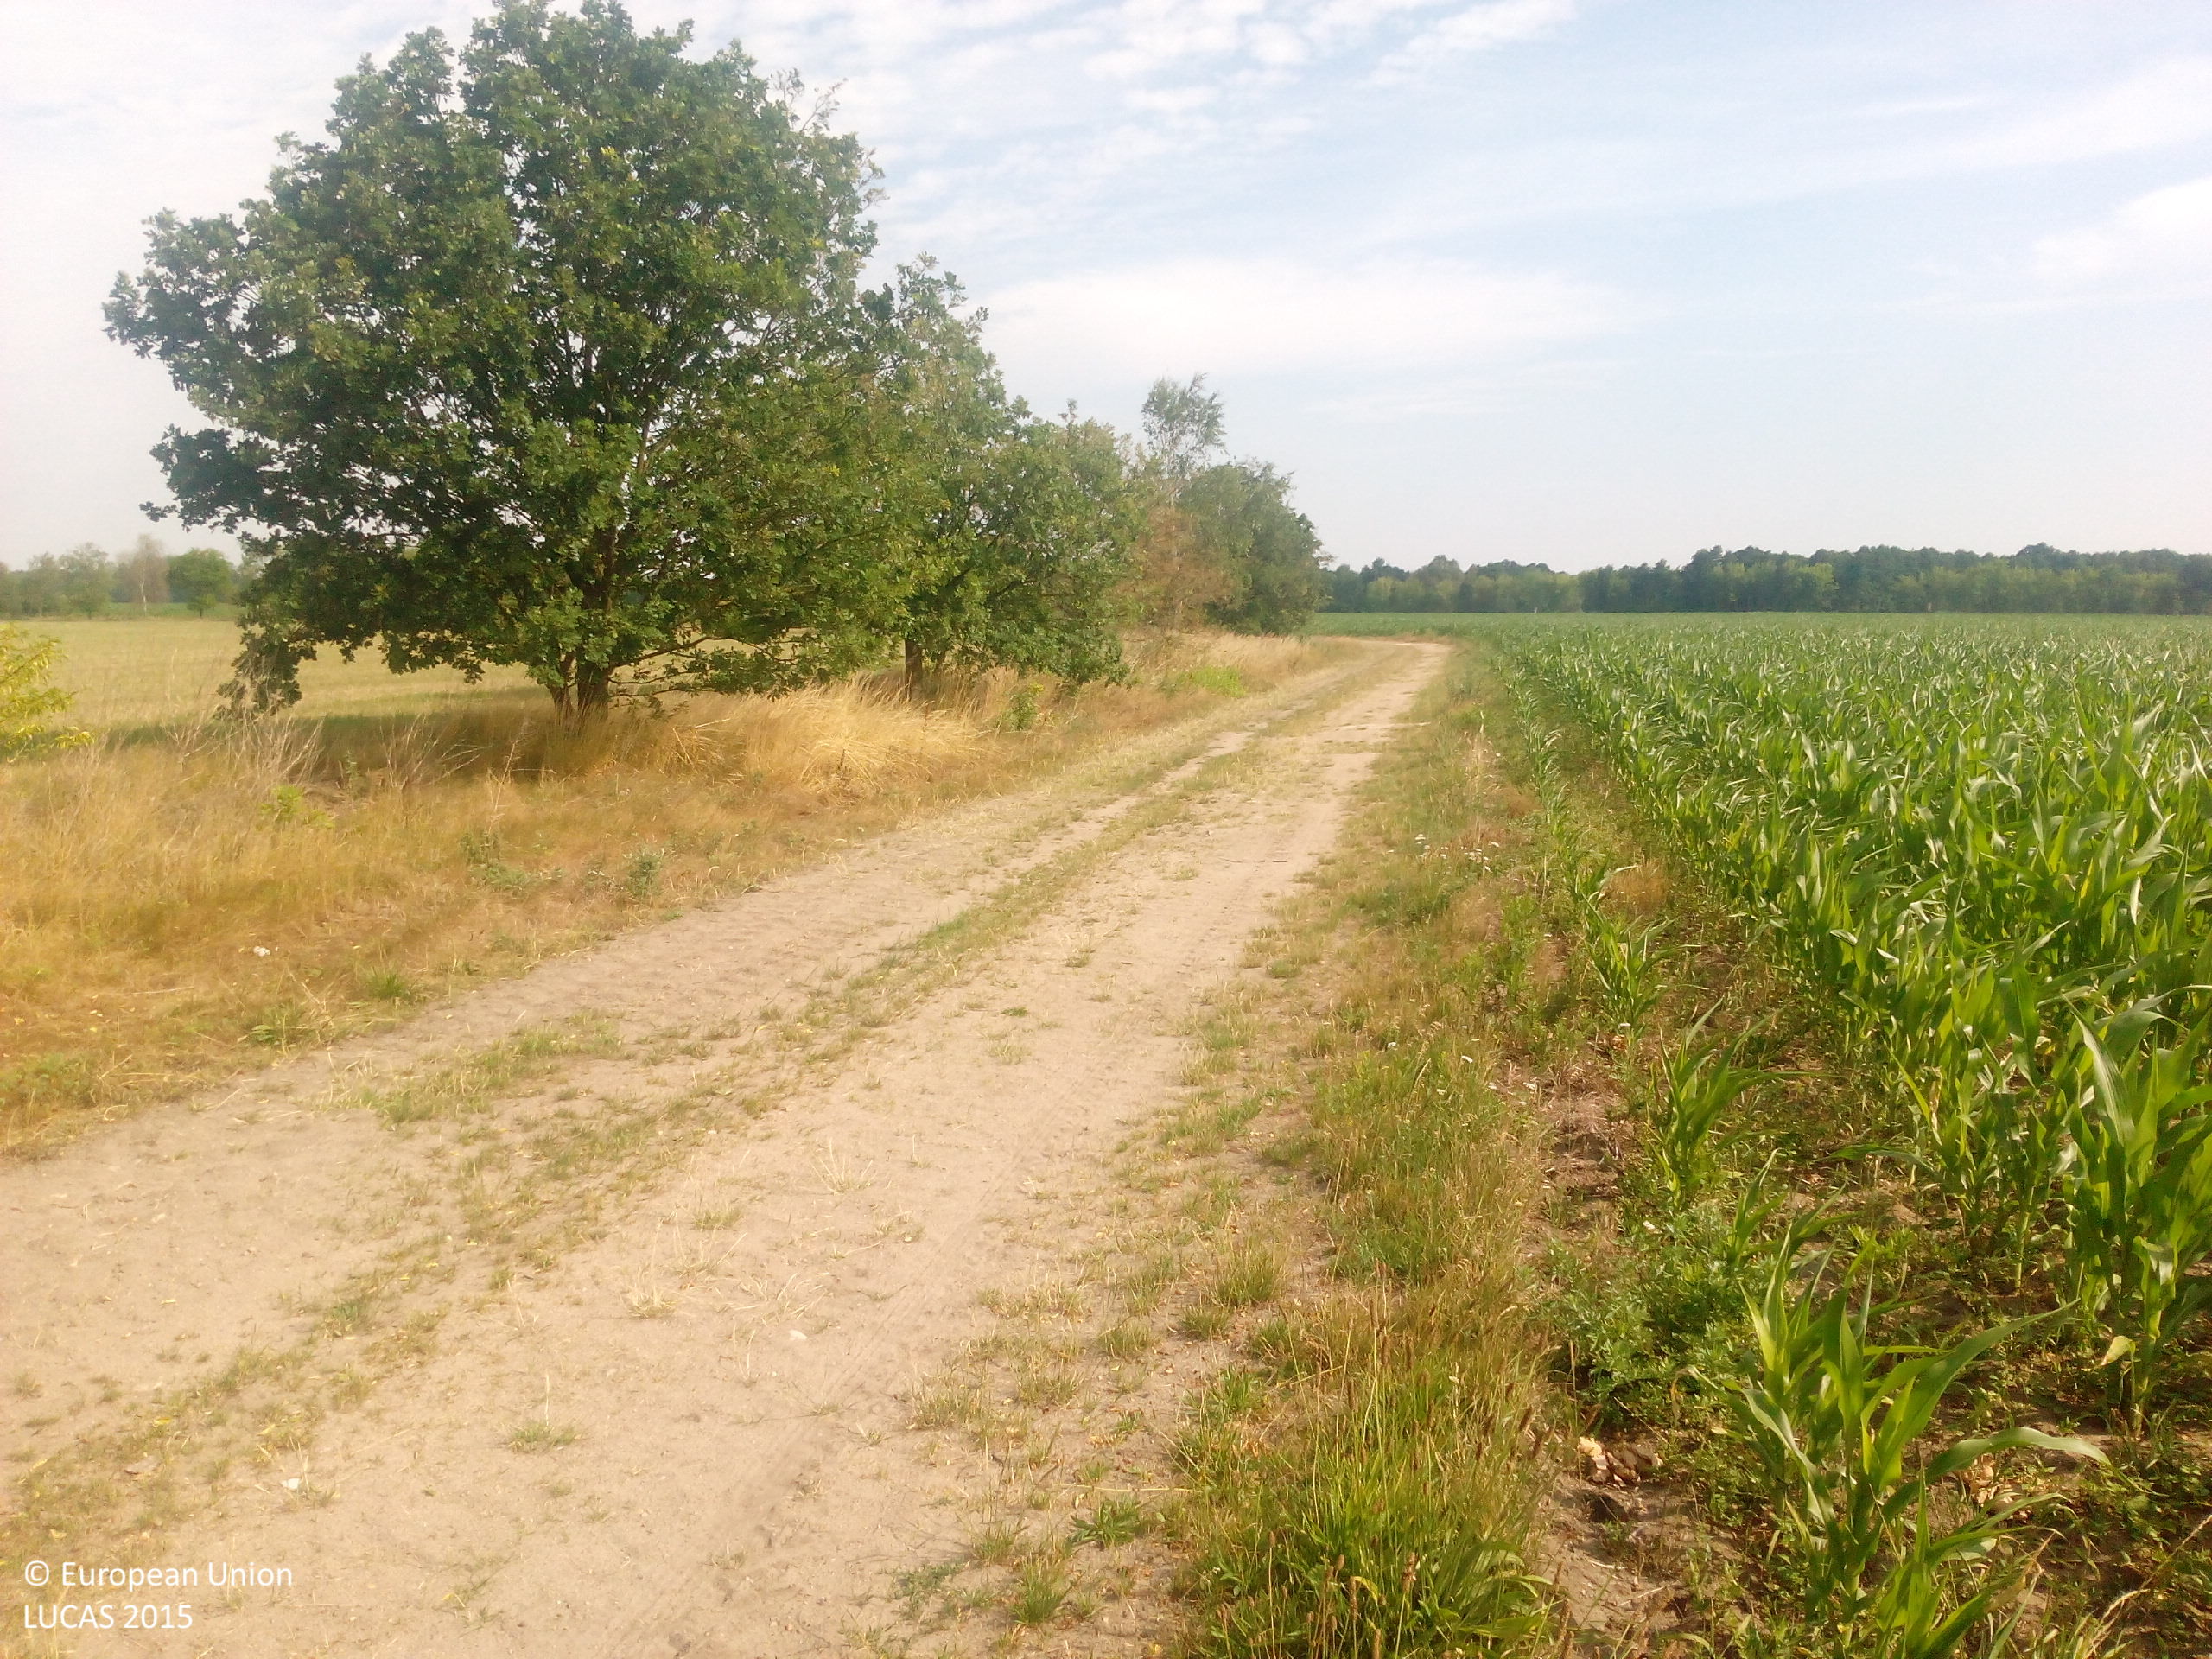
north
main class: Cropland
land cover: Maize
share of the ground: > 75 %
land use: Agriculture (excluding fallow land and kitchen gardens)
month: July
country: DE
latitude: 52.5338
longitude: 11.1348
